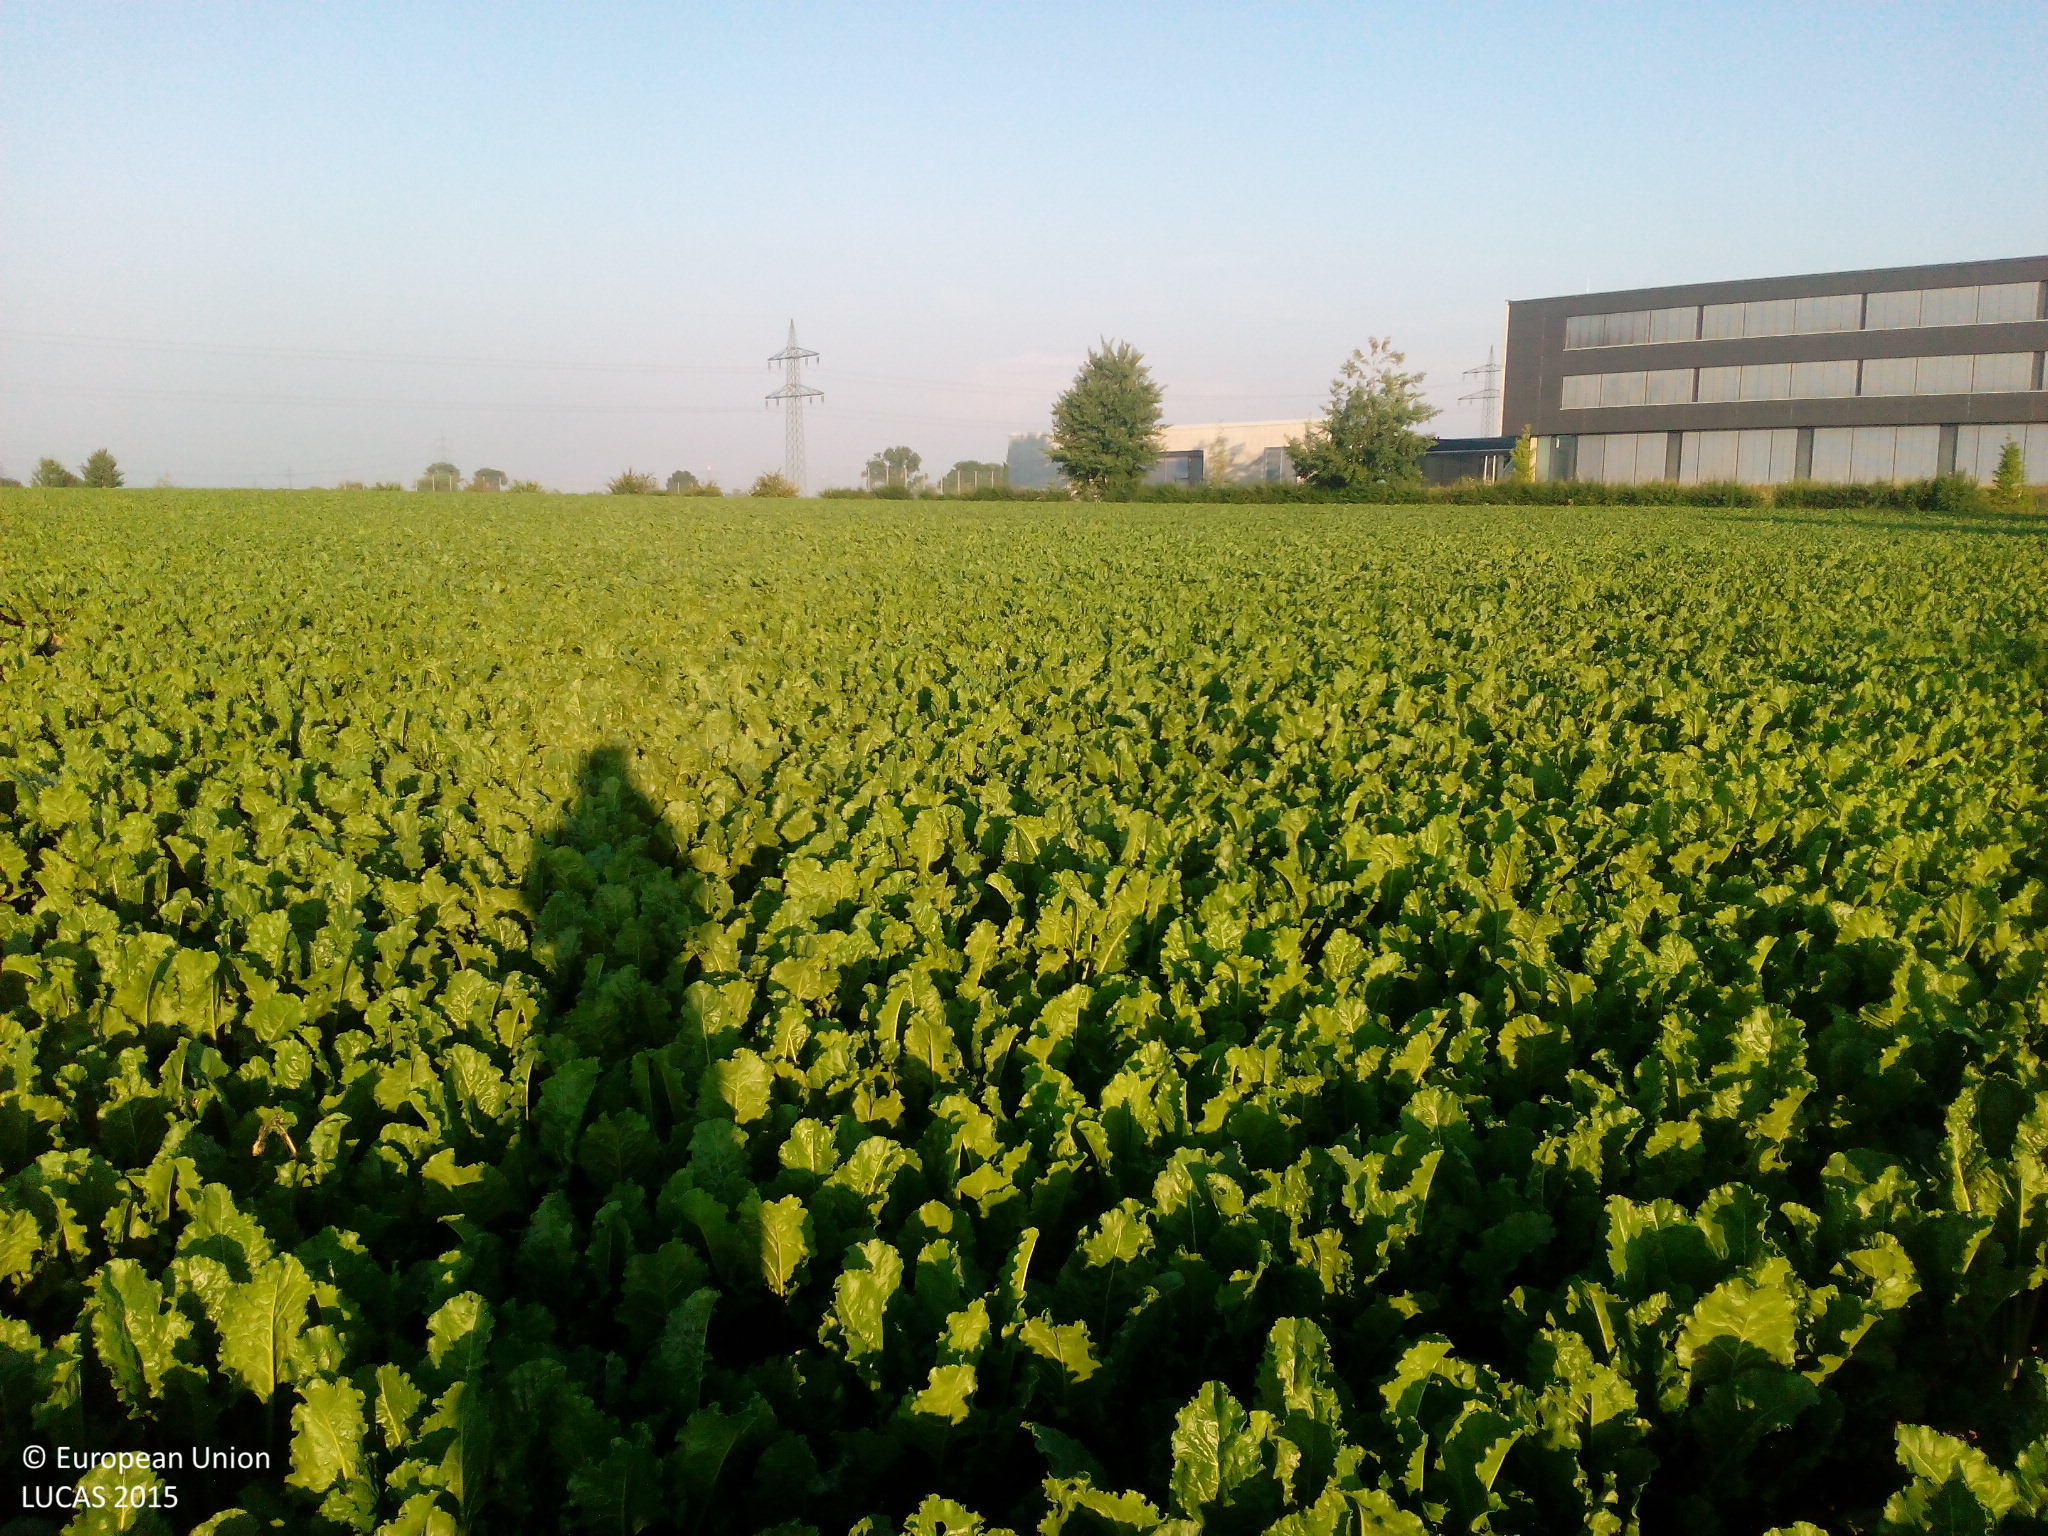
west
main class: Cropland
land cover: Sugar beet
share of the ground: > 75 %
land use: Agriculture (excluding fallow land and kitchen gardens)
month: July
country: DE
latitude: 48.8074
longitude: 11.4836
